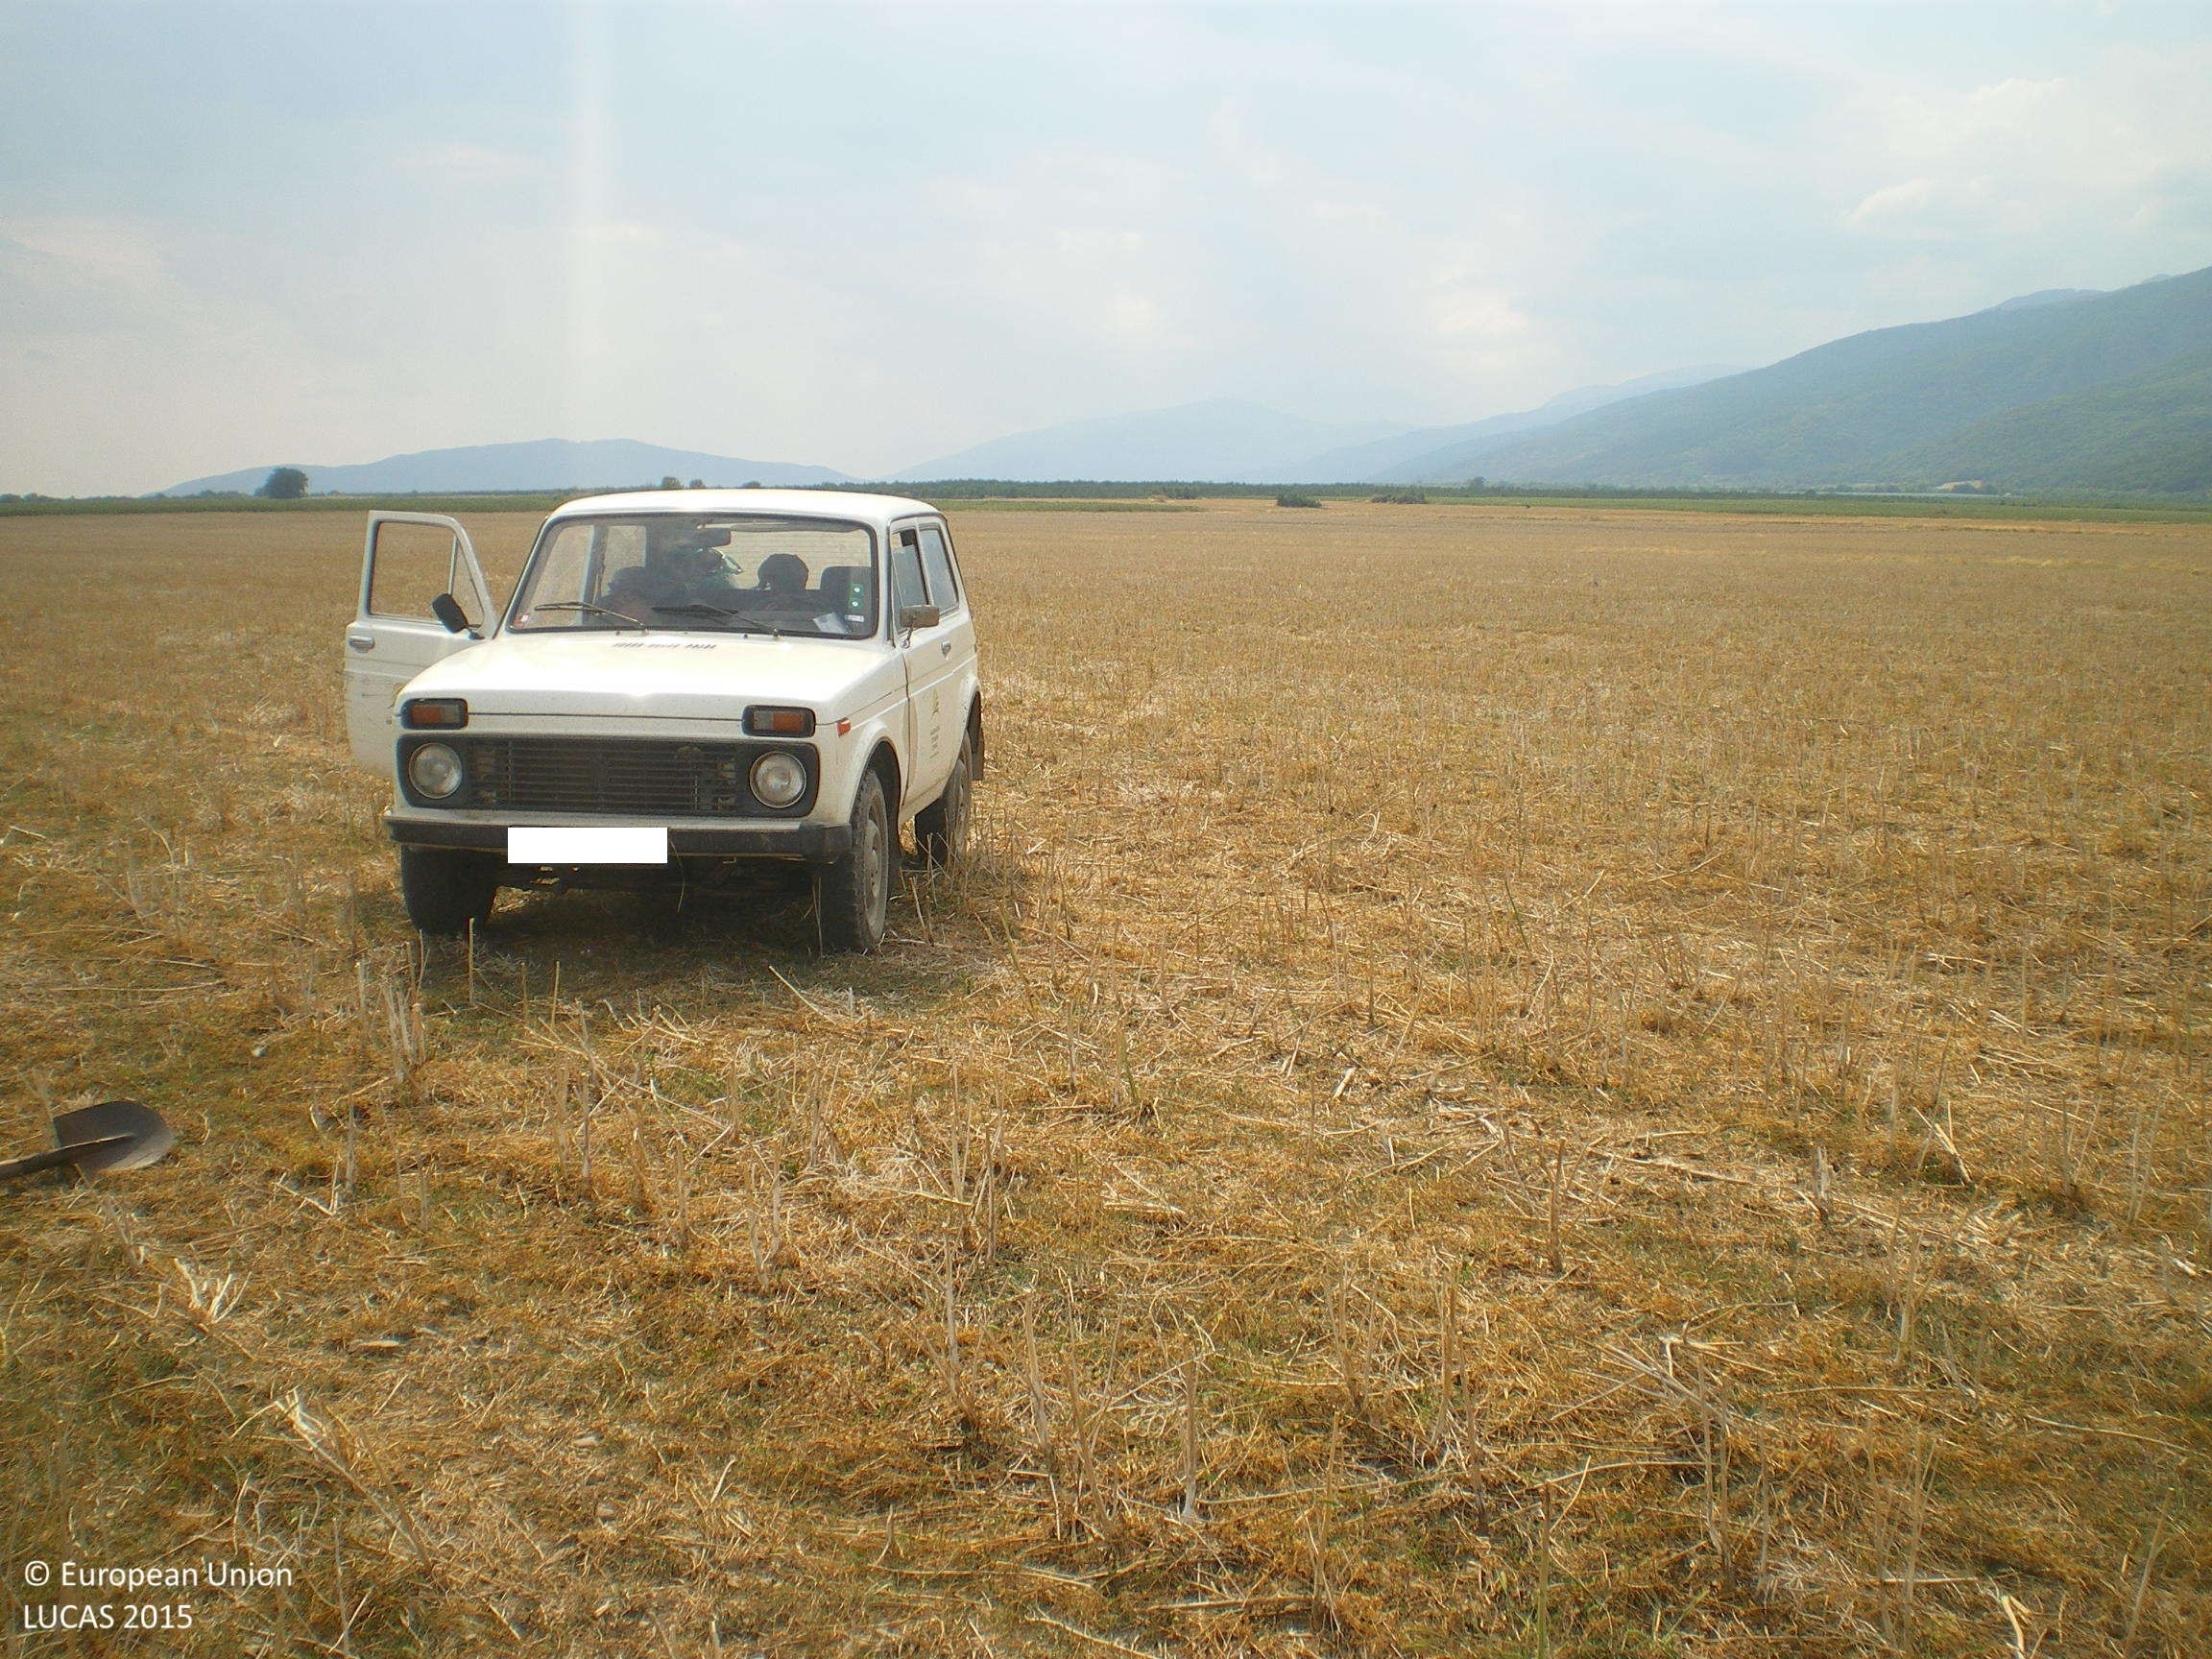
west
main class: Cropland
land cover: Rape and turnip rape
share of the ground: < 10 %
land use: Agriculture (excluding fallow land and kitchen gardens)
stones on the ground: > 50 %
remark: Harvested field
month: July
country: BG
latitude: 42.6576
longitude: 25.1804
